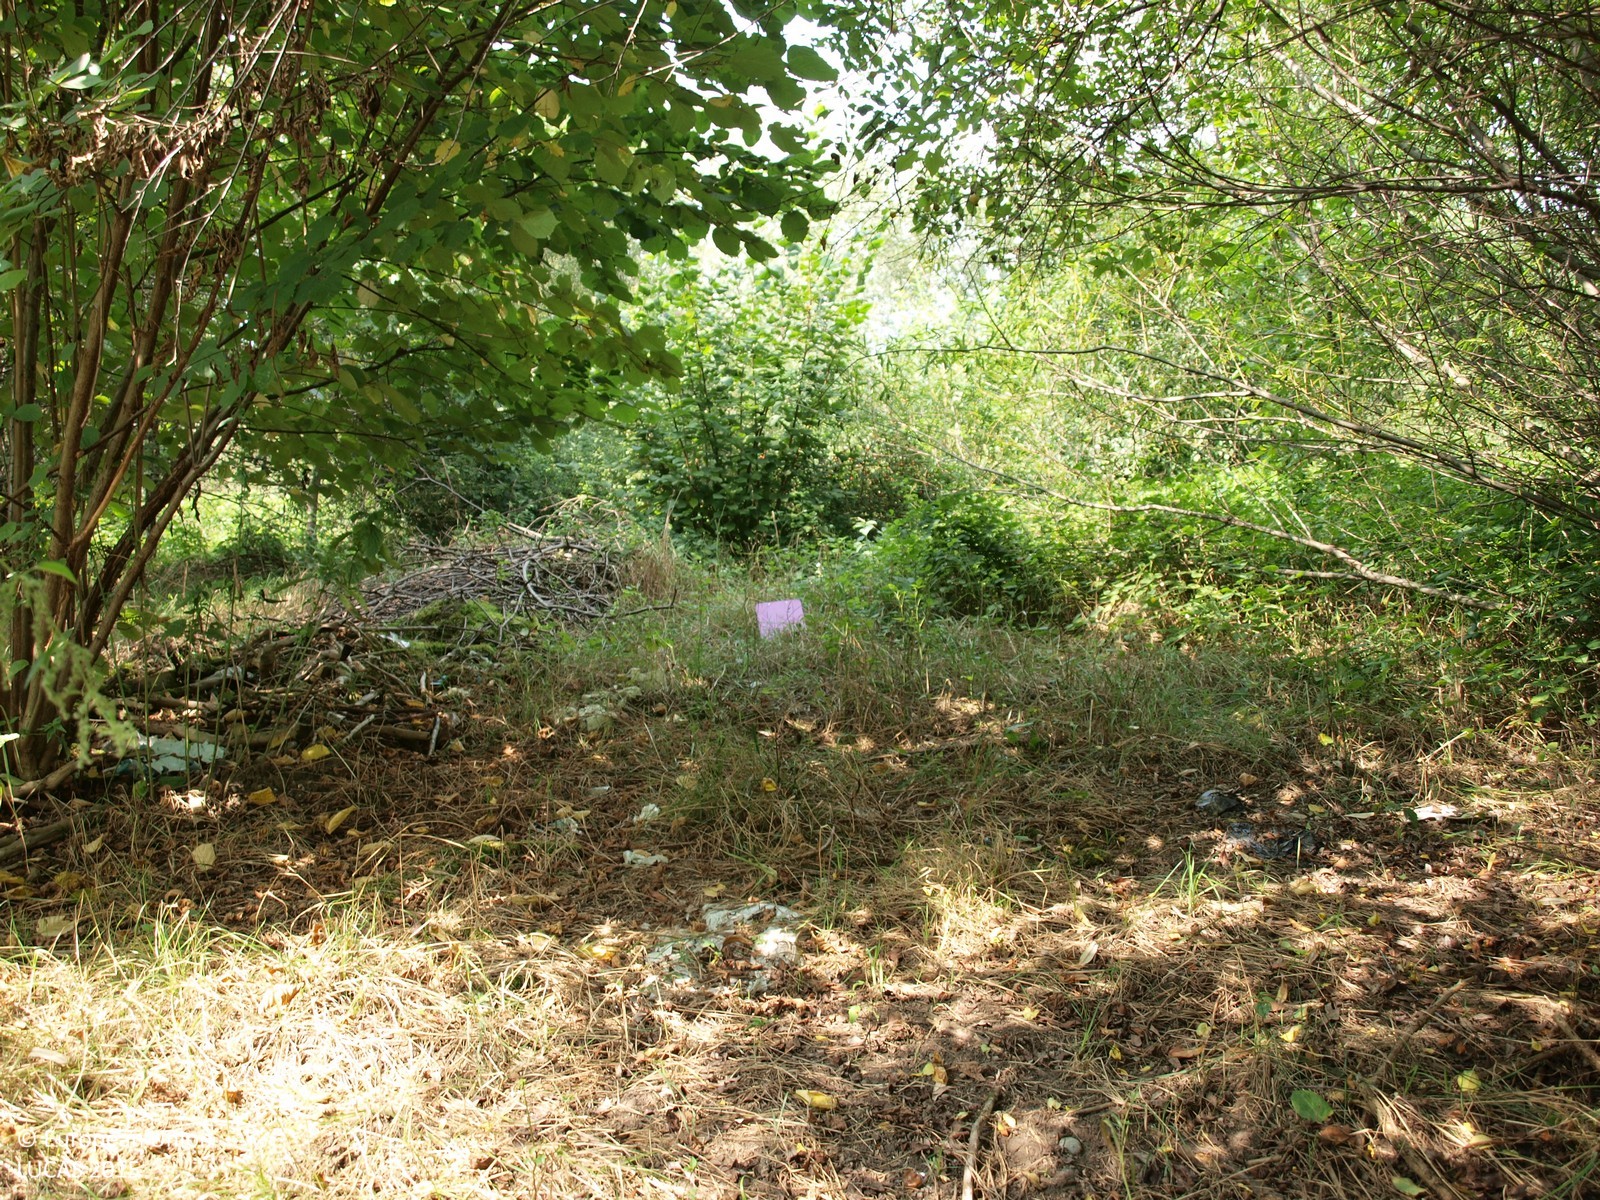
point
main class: Shrubland
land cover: Shrubland with sparse tree cover
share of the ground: > 75 %
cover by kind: shrubs 95 %, broadleaved forest trees 5 %
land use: Semi-natural and natural areas not in use
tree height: > 5 m
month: August
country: HR
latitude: 45.6806
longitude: 16.2506
